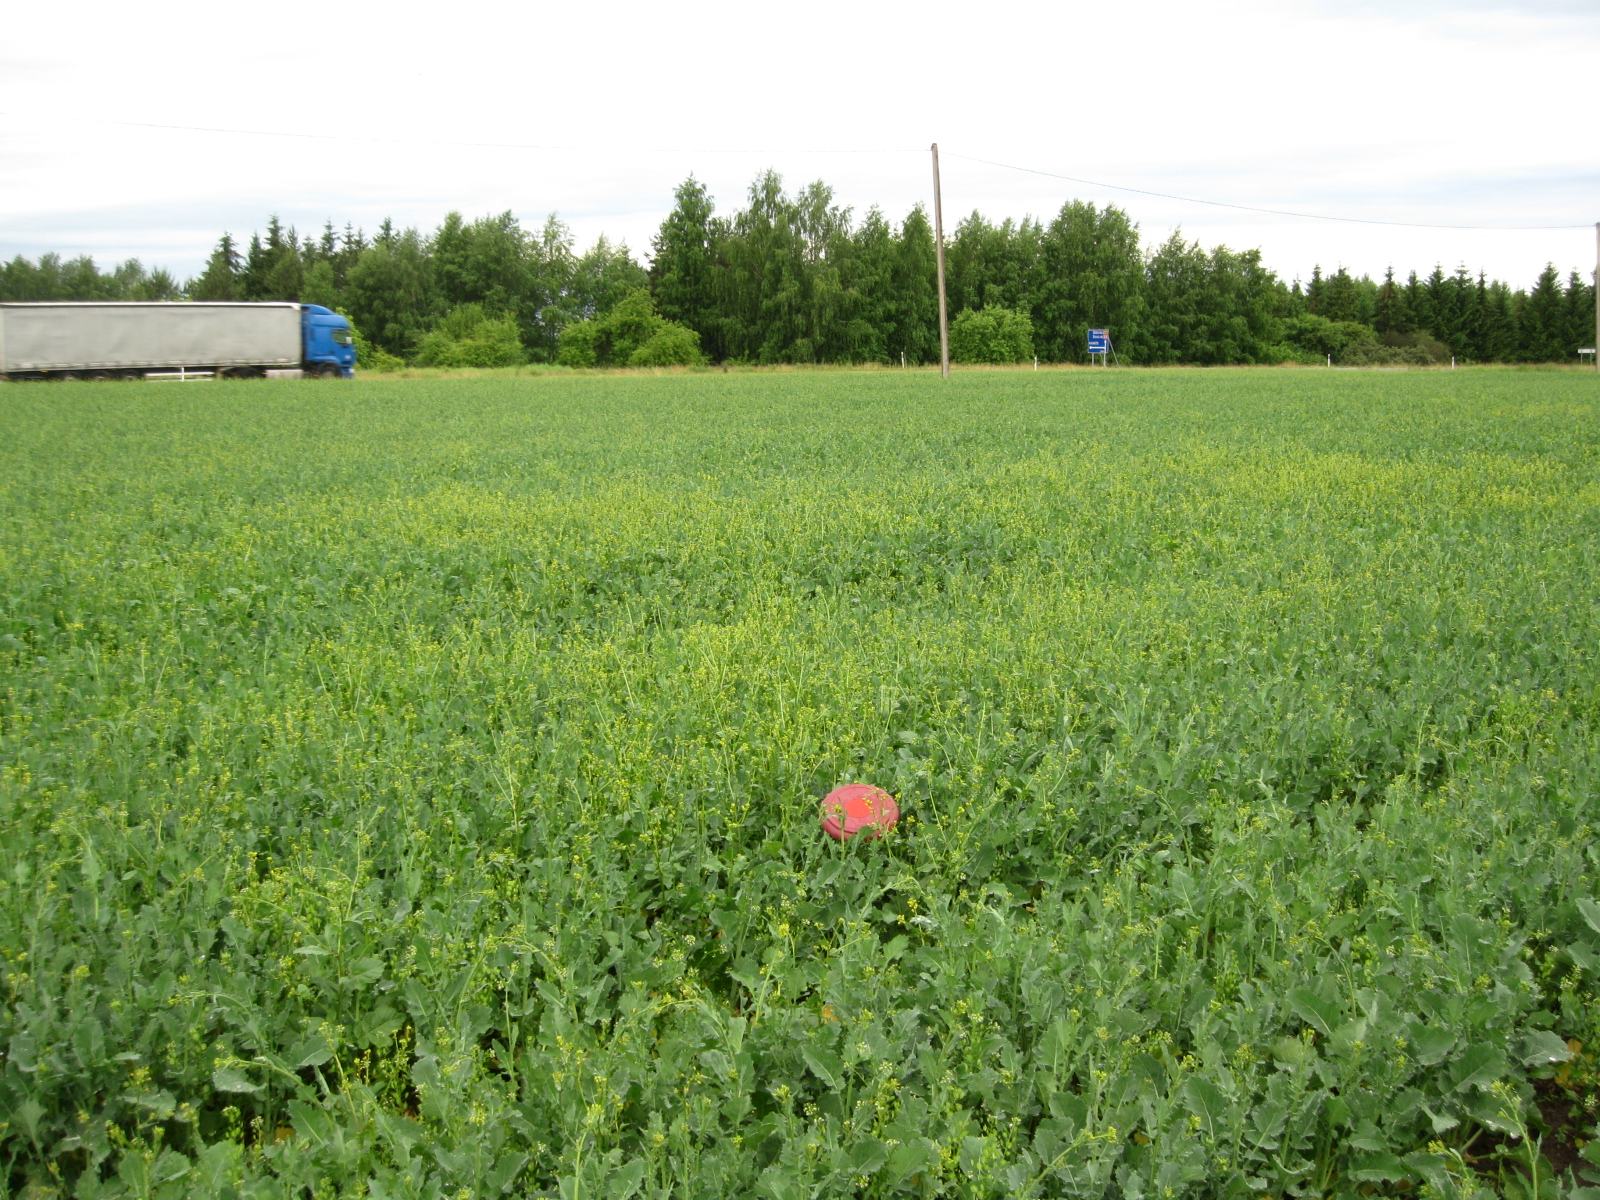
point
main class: Cropland
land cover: Rape and turnip rape
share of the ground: > 75 %
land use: Agriculture (excluding fallow land and kitchen gardens)
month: June
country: LT
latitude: 55.4140
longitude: 23.8448
